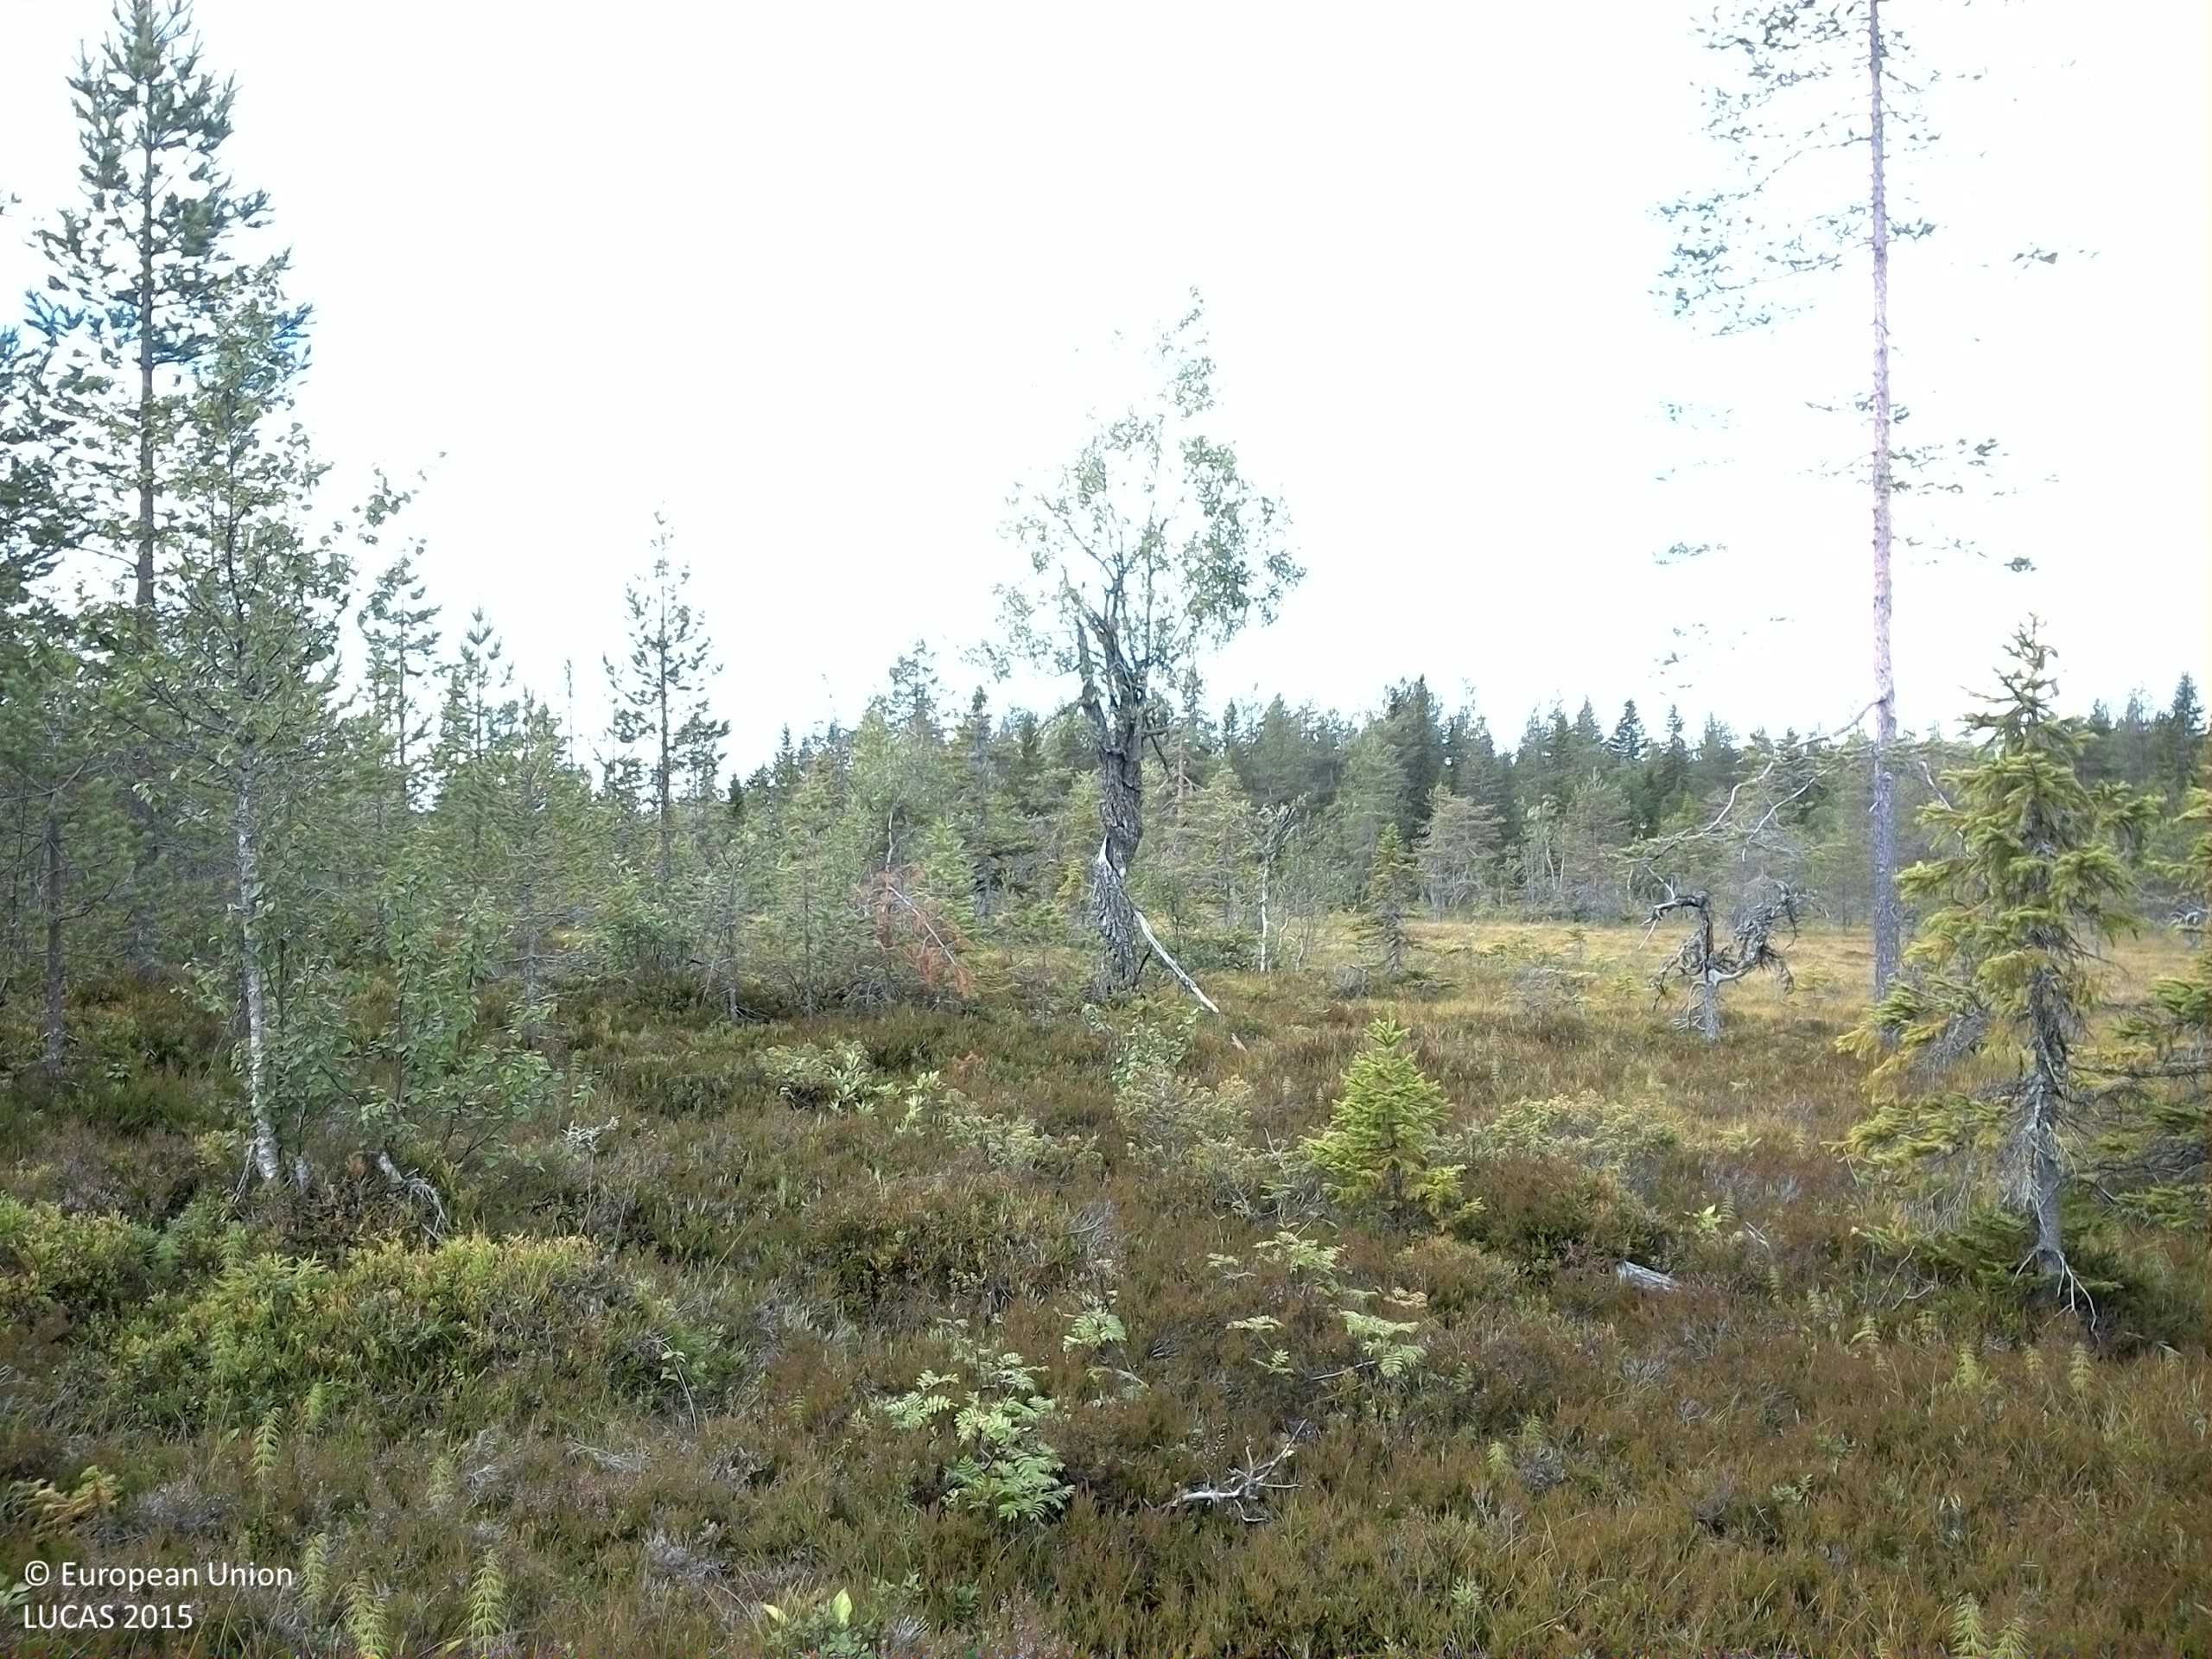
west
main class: Woodland
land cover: Pine dominated coniferous woodland
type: boreal forest
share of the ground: 25 - 50 %
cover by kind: shrubs 65 %, coniferous forest trees 25 %, broadleaved forest trees 5 %, lichens and mosses 5 %
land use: Forestry
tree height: < 5 m
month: August
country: SE
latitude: 63.7573
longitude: 18.0609
